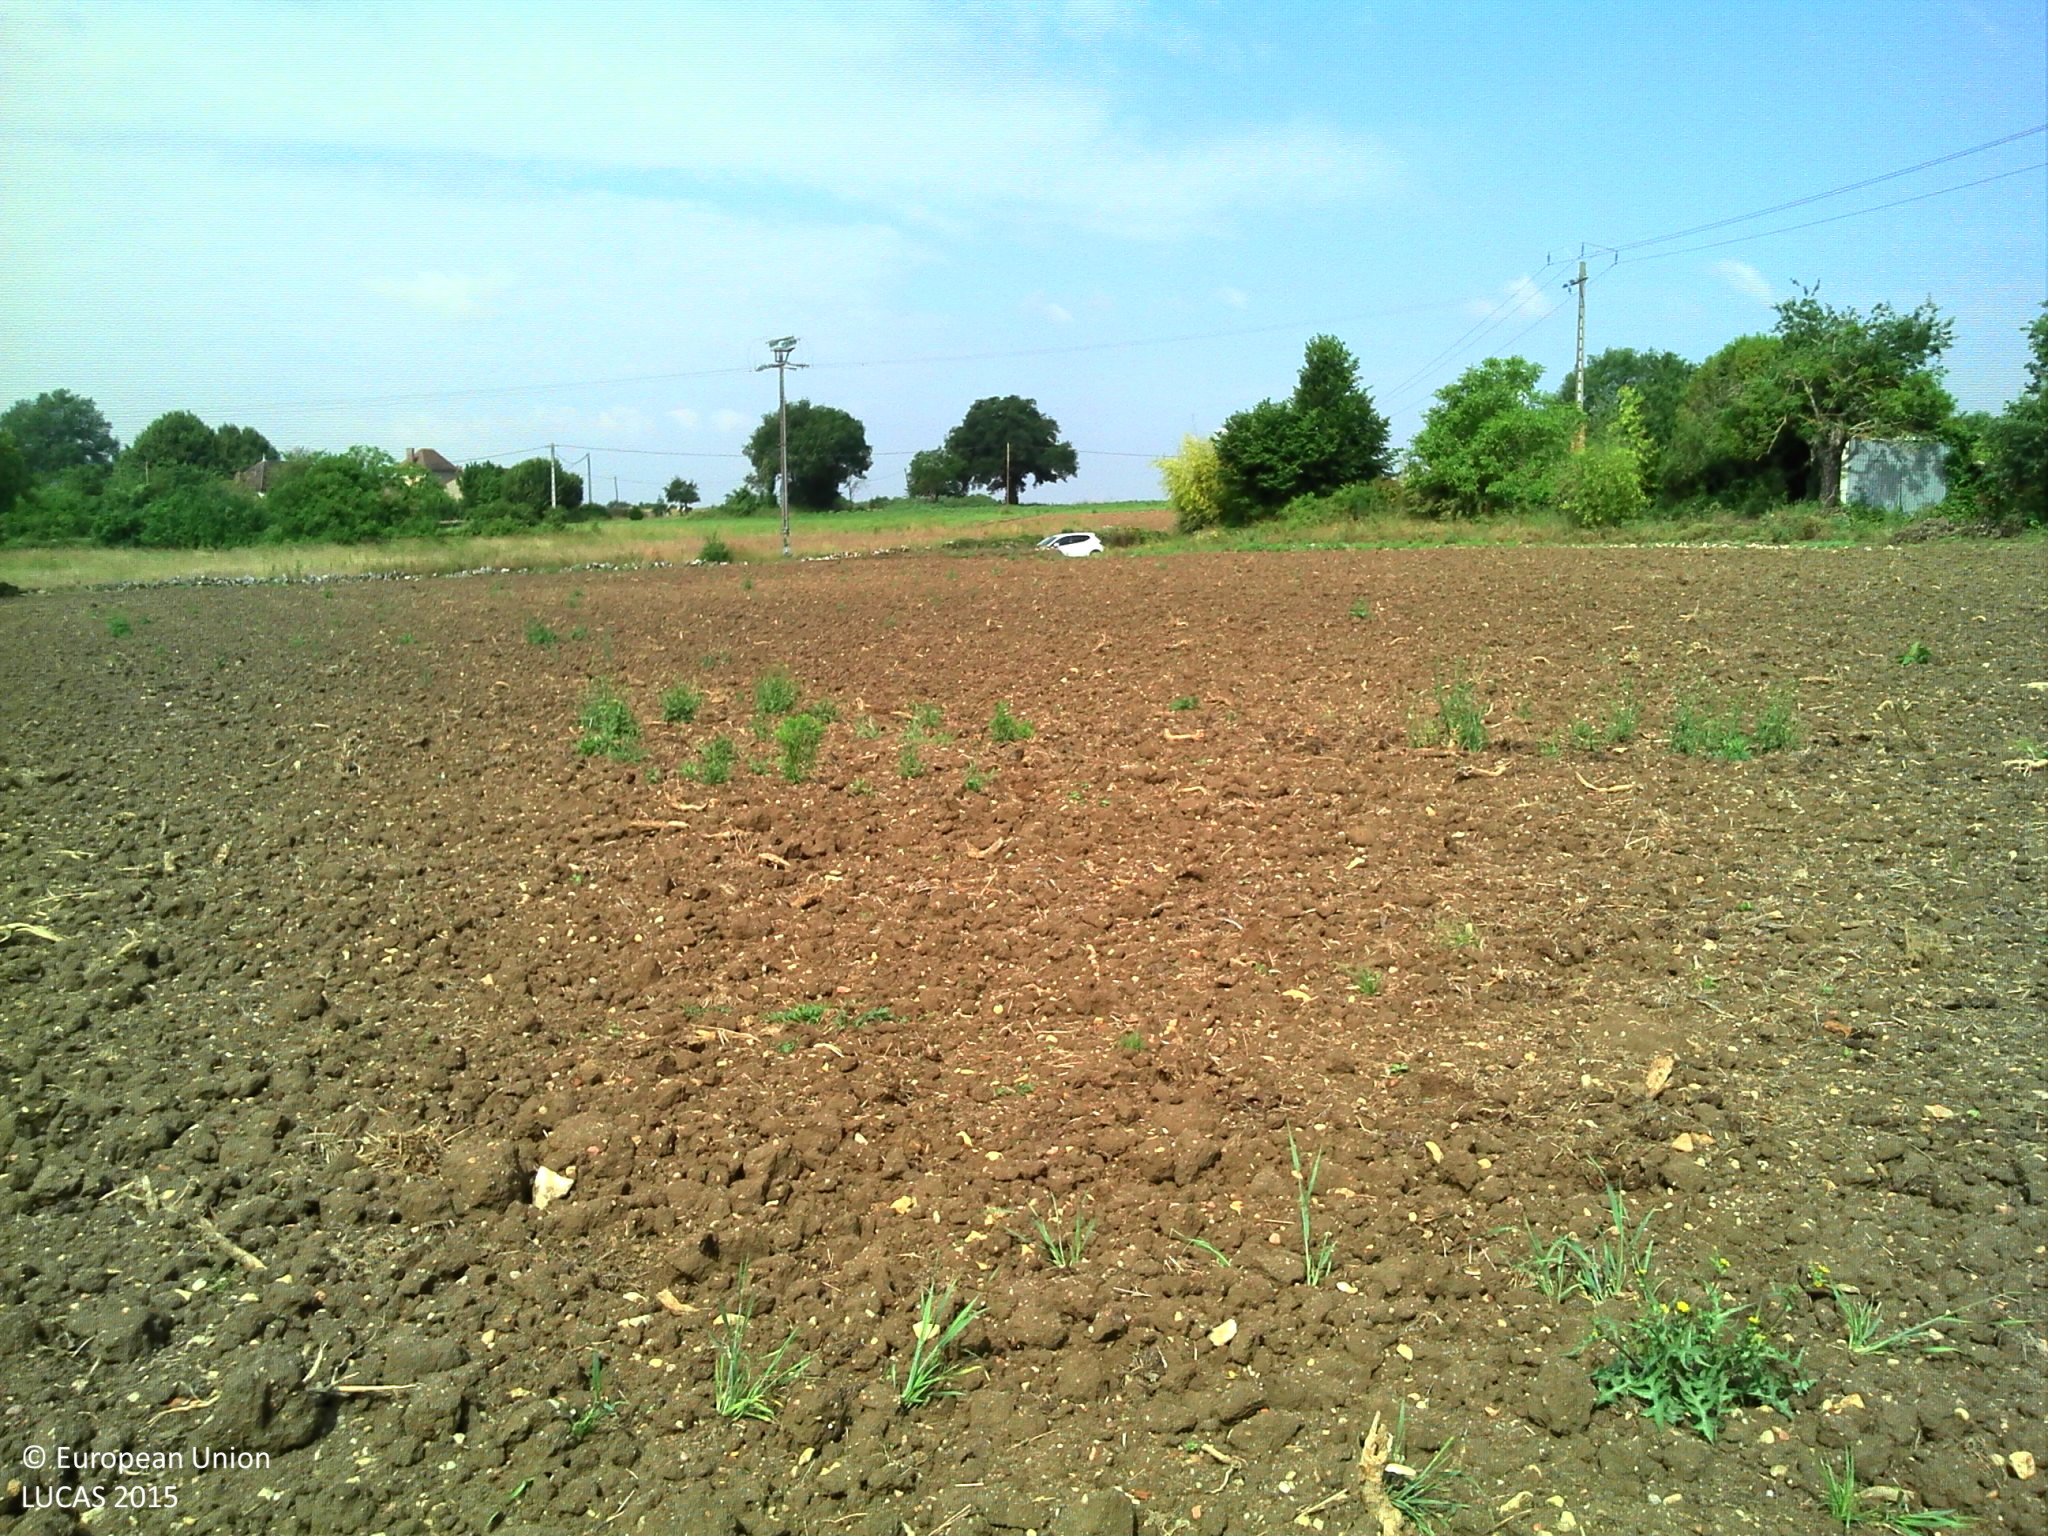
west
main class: Cropland
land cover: Rape and turnip rape
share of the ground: > 75 %
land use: Agriculture (excluding fallow land and kitchen gardens)
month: June
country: FR
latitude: 46.5756
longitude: 0.8643
